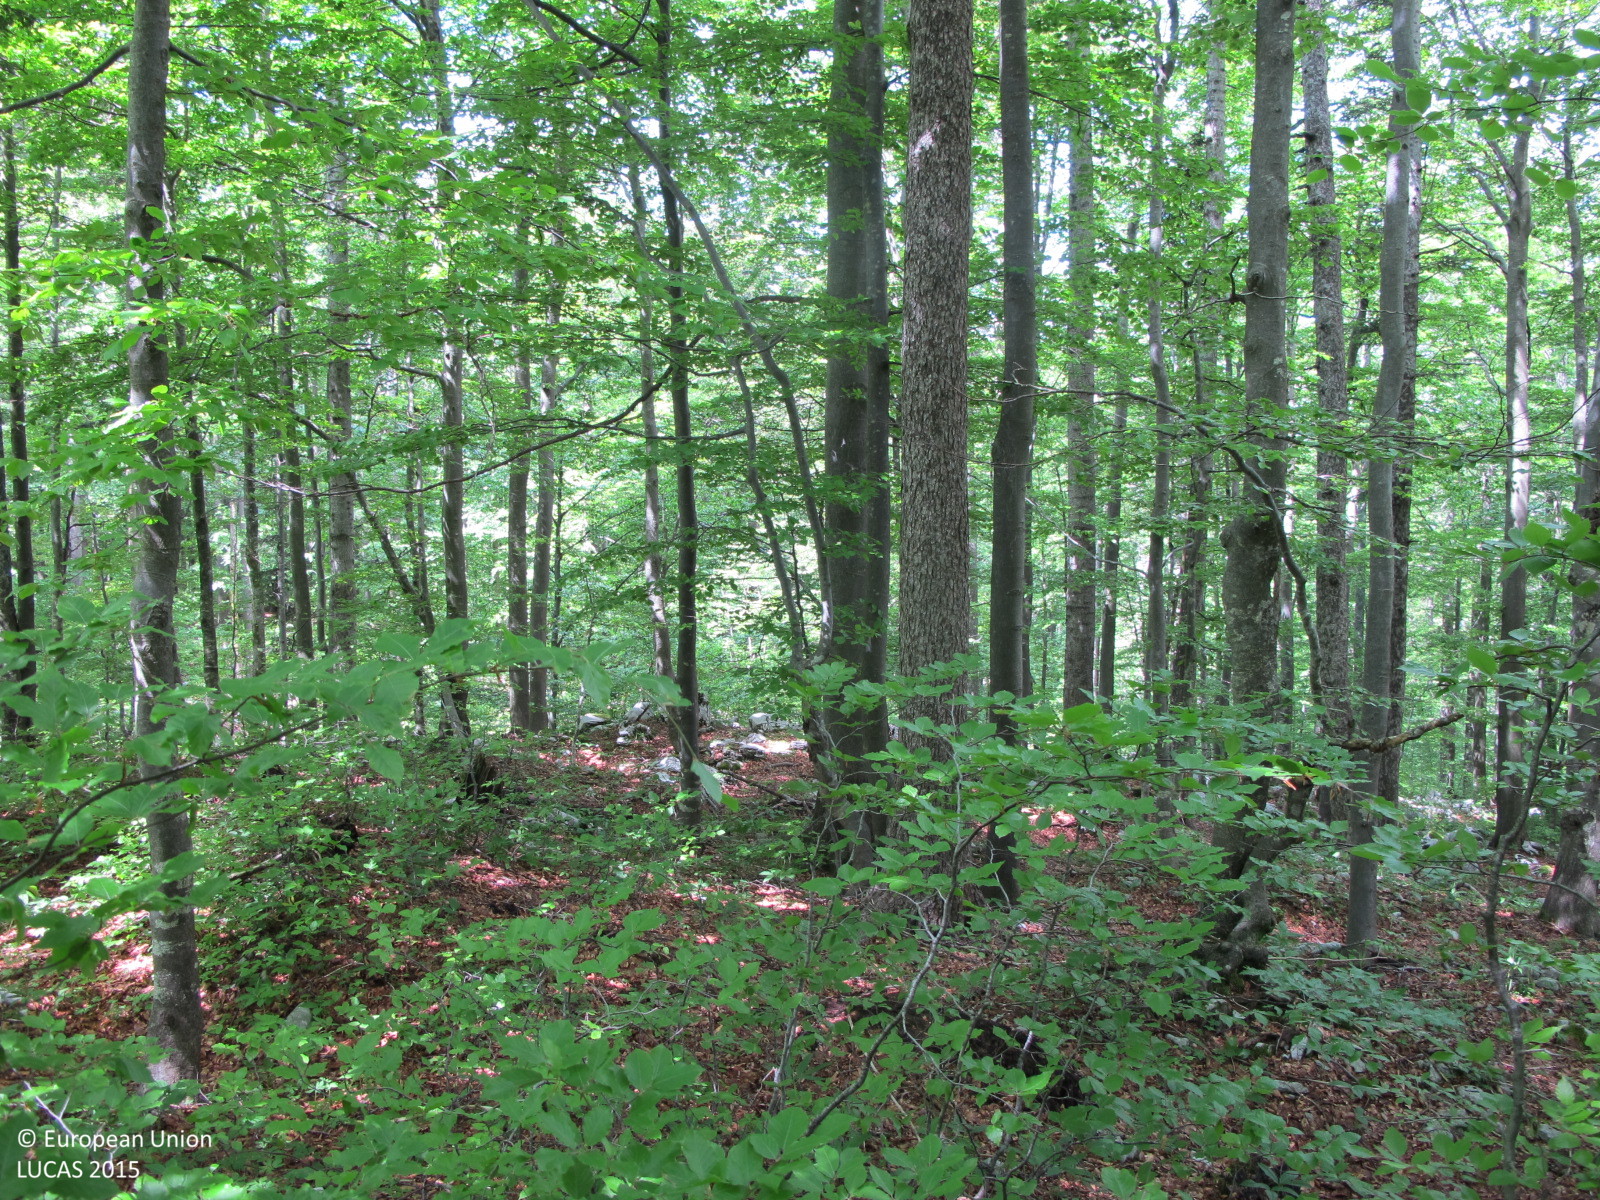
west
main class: Woodland
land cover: Broadleaved woodland
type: mountainous beech forest
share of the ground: > 75 %
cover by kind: broadleaved forest trees 90 %, coniferous forest trees 5 %, shrubs 5 %
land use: Forestry
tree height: > 5 m
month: May
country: HR
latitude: 45.4611
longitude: 14.5353
